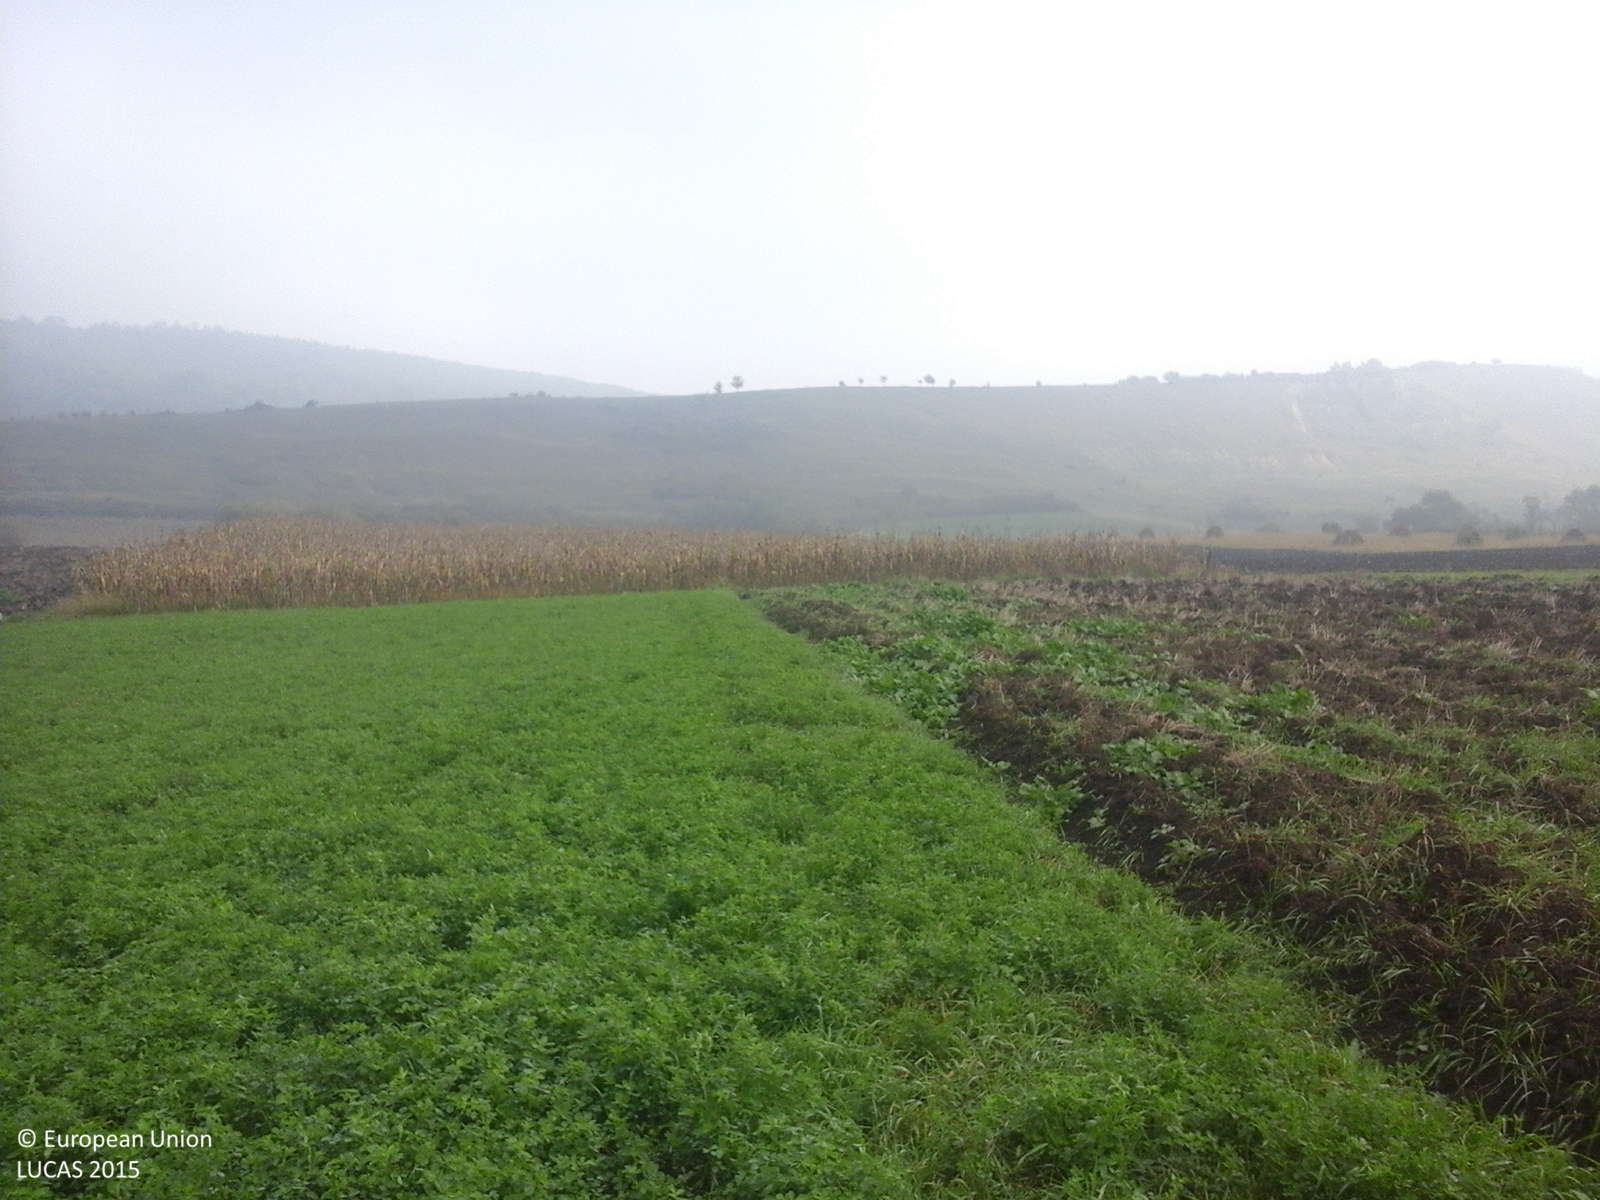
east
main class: Cropland
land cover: Lucerne
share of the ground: > 75 %
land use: Agriculture (excluding fallow land and kitchen gardens)
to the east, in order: Lucerne; Common wheat; Grass margins; Tracks; Grass margins; Maize; Common wheat; Maize
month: October
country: RO
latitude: 46.5279
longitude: 24.3595
